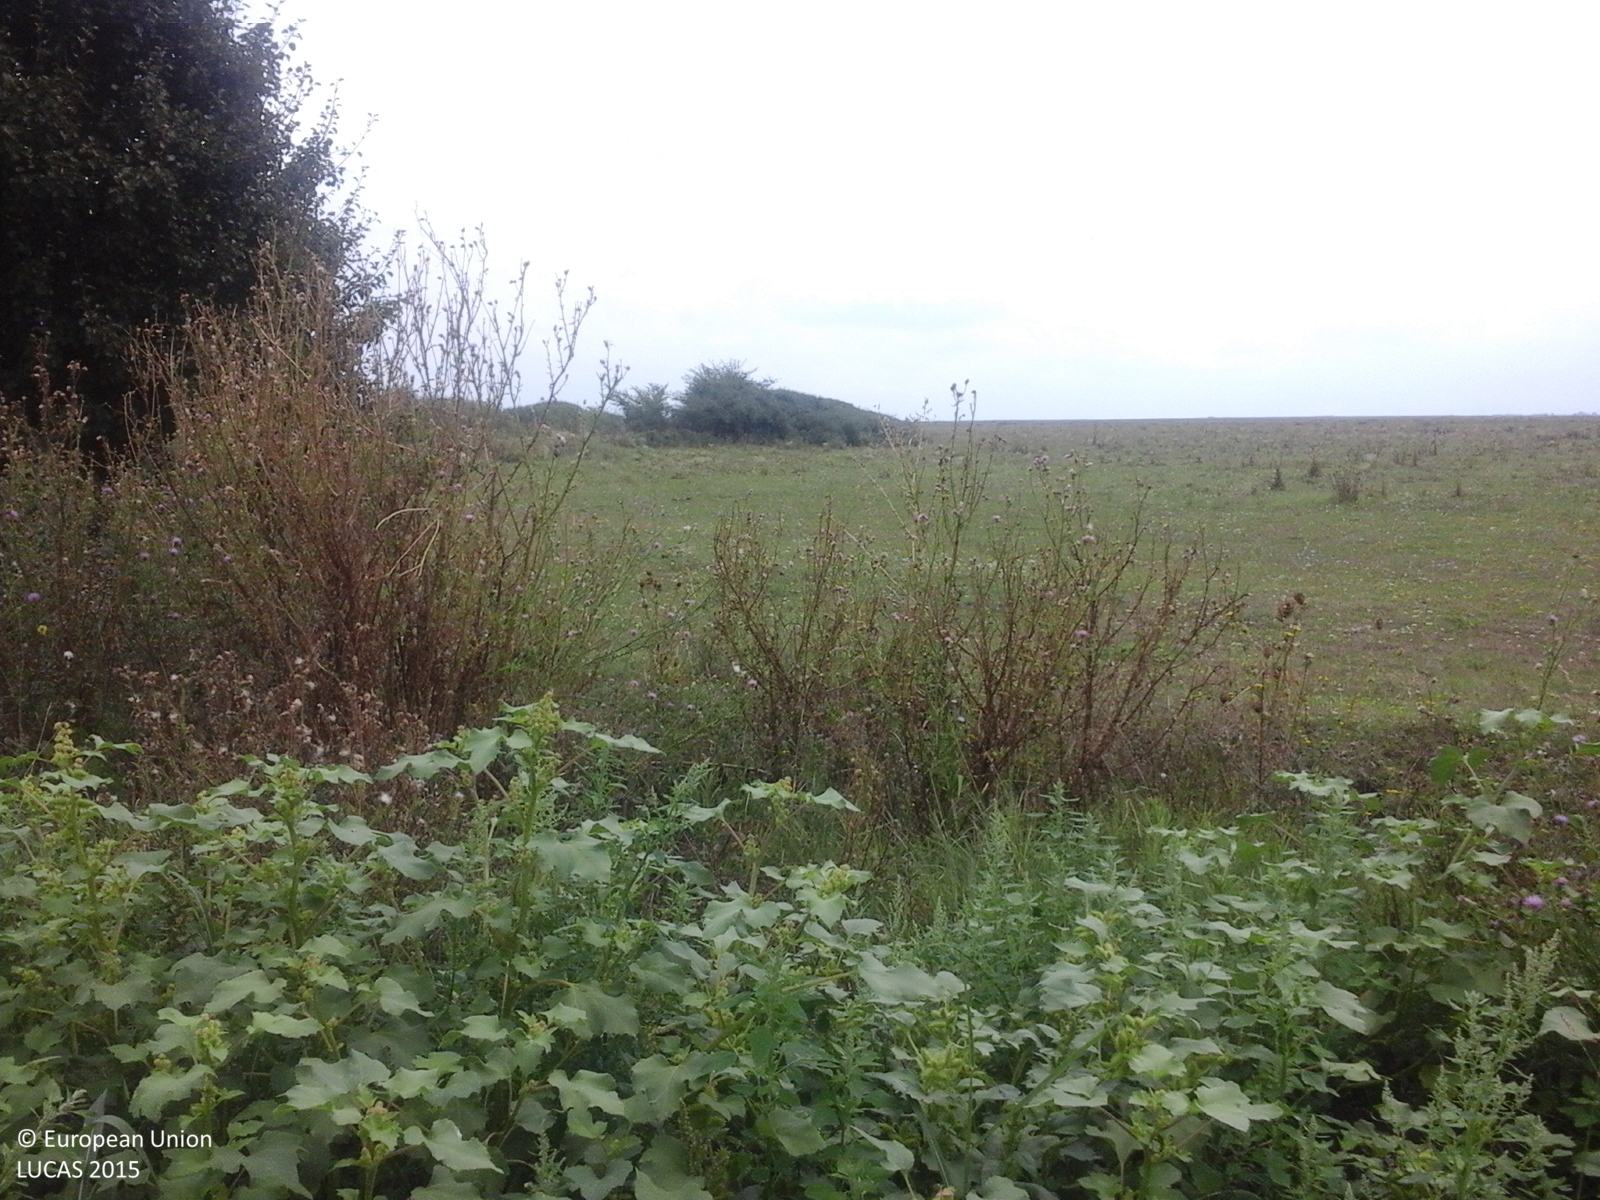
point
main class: Grassland
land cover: Grassland without tree/shrub cover
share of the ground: > 75 %
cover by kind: herbaceous plants 100 %
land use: Agriculture (excluding fallow land and kitchen gardens)
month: August
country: RO
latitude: 45.4413
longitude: 20.9565
